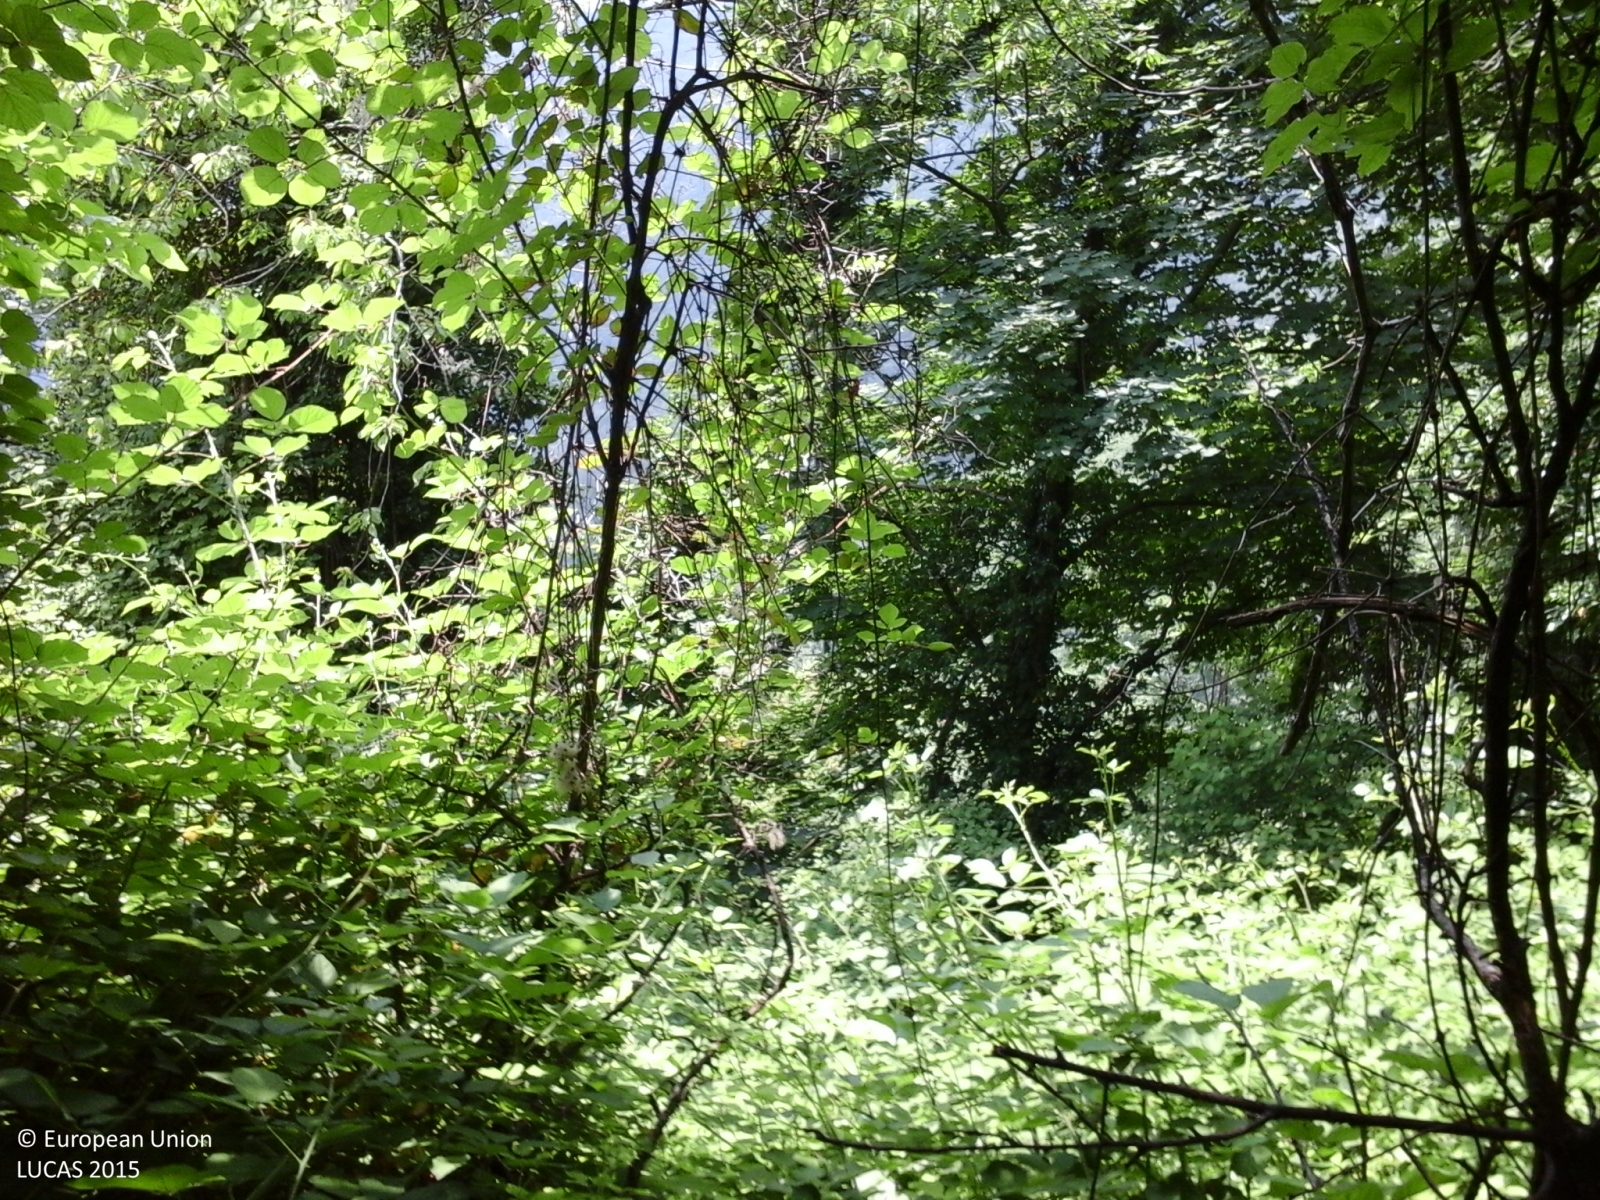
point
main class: Woodland
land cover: Broadleaved woodland
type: thermophilous deciduous forest
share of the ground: > 75 %
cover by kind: broadleaved forest trees 100 %
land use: Semi-natural and natural areas not in use
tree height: > 5 m
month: June
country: IT
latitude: 45.7810
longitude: 11.5796
